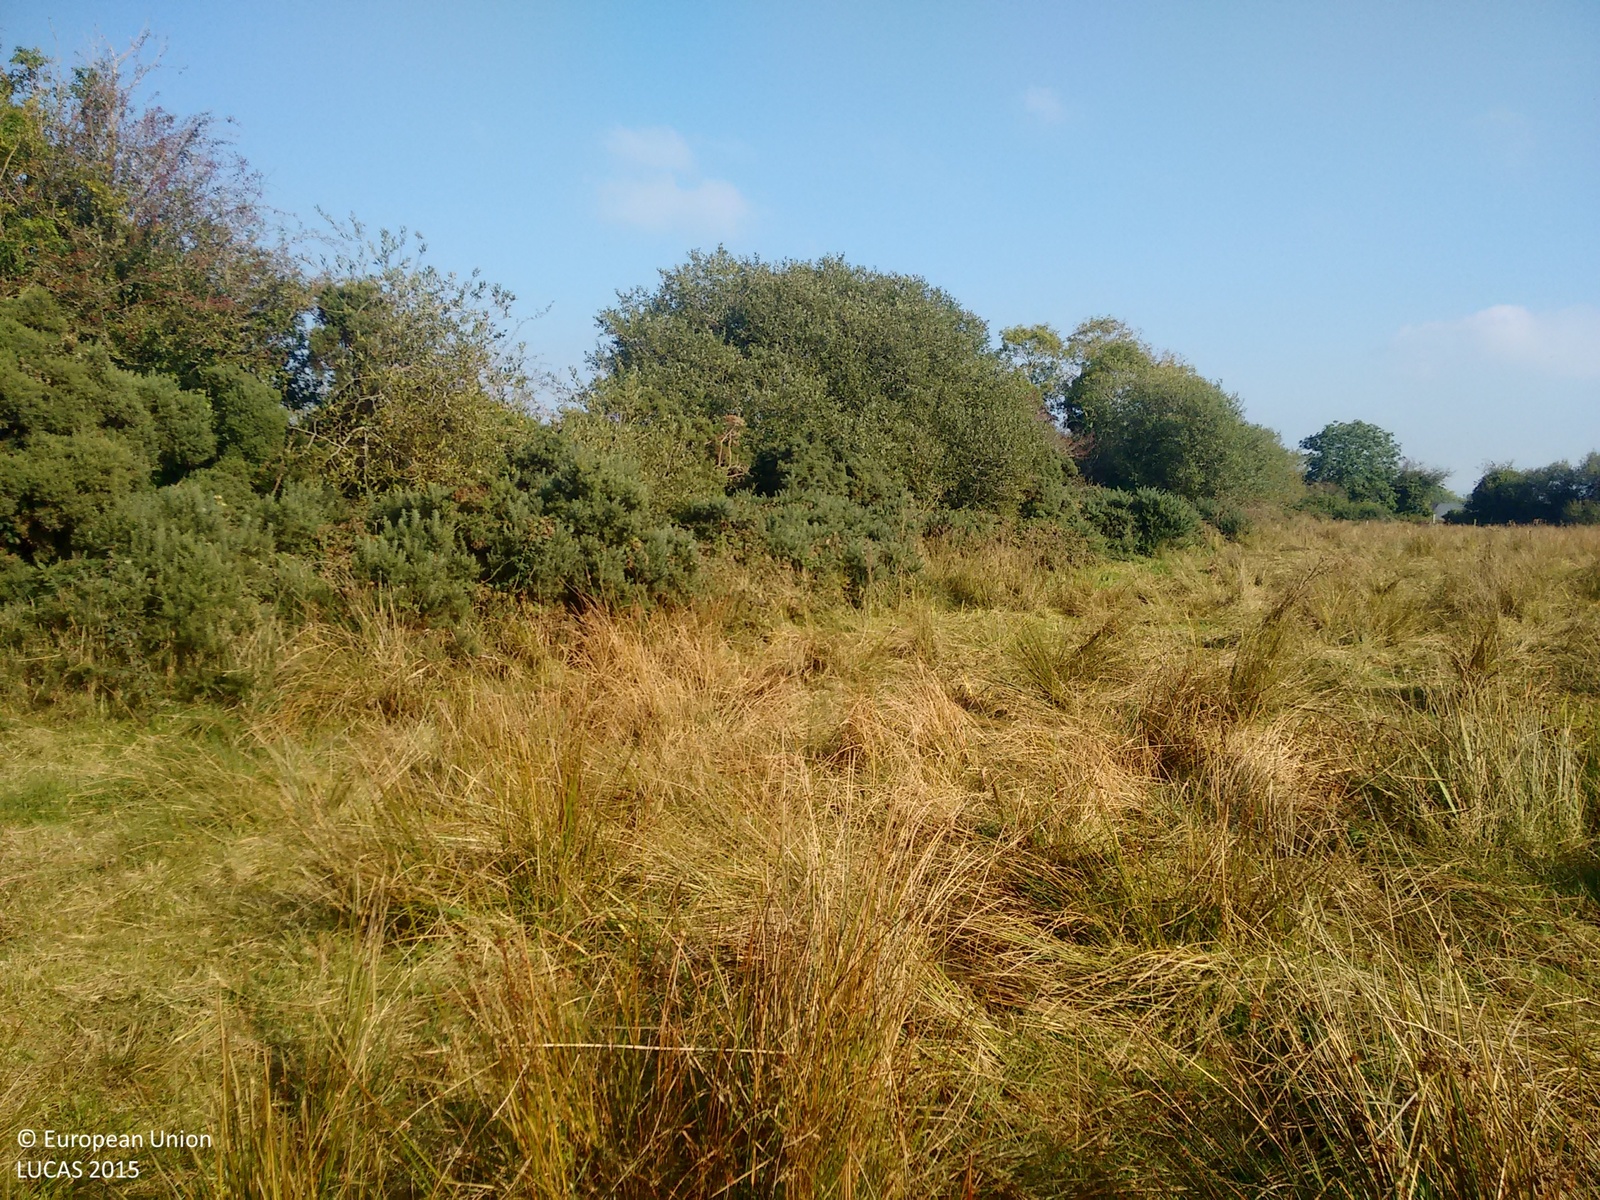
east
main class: Grassland
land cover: Grassland without tree/shrub cover
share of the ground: > 75 %
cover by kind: herbaceous plants 75 %, shrubs 5 %
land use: Agriculture (excluding fallow land and kitchen gardens)
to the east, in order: Grassland without tree/shrub cover; Broadleaved woodland; Grassland without tree/shrub cover; Fences; Broadleaved woodland; Grassland without tree/shrub cover; Electric lines; Grassland without tree/shrub cover; Artificial constructions in urban areas
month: October
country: IE
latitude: 52.4700
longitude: -9.1038
